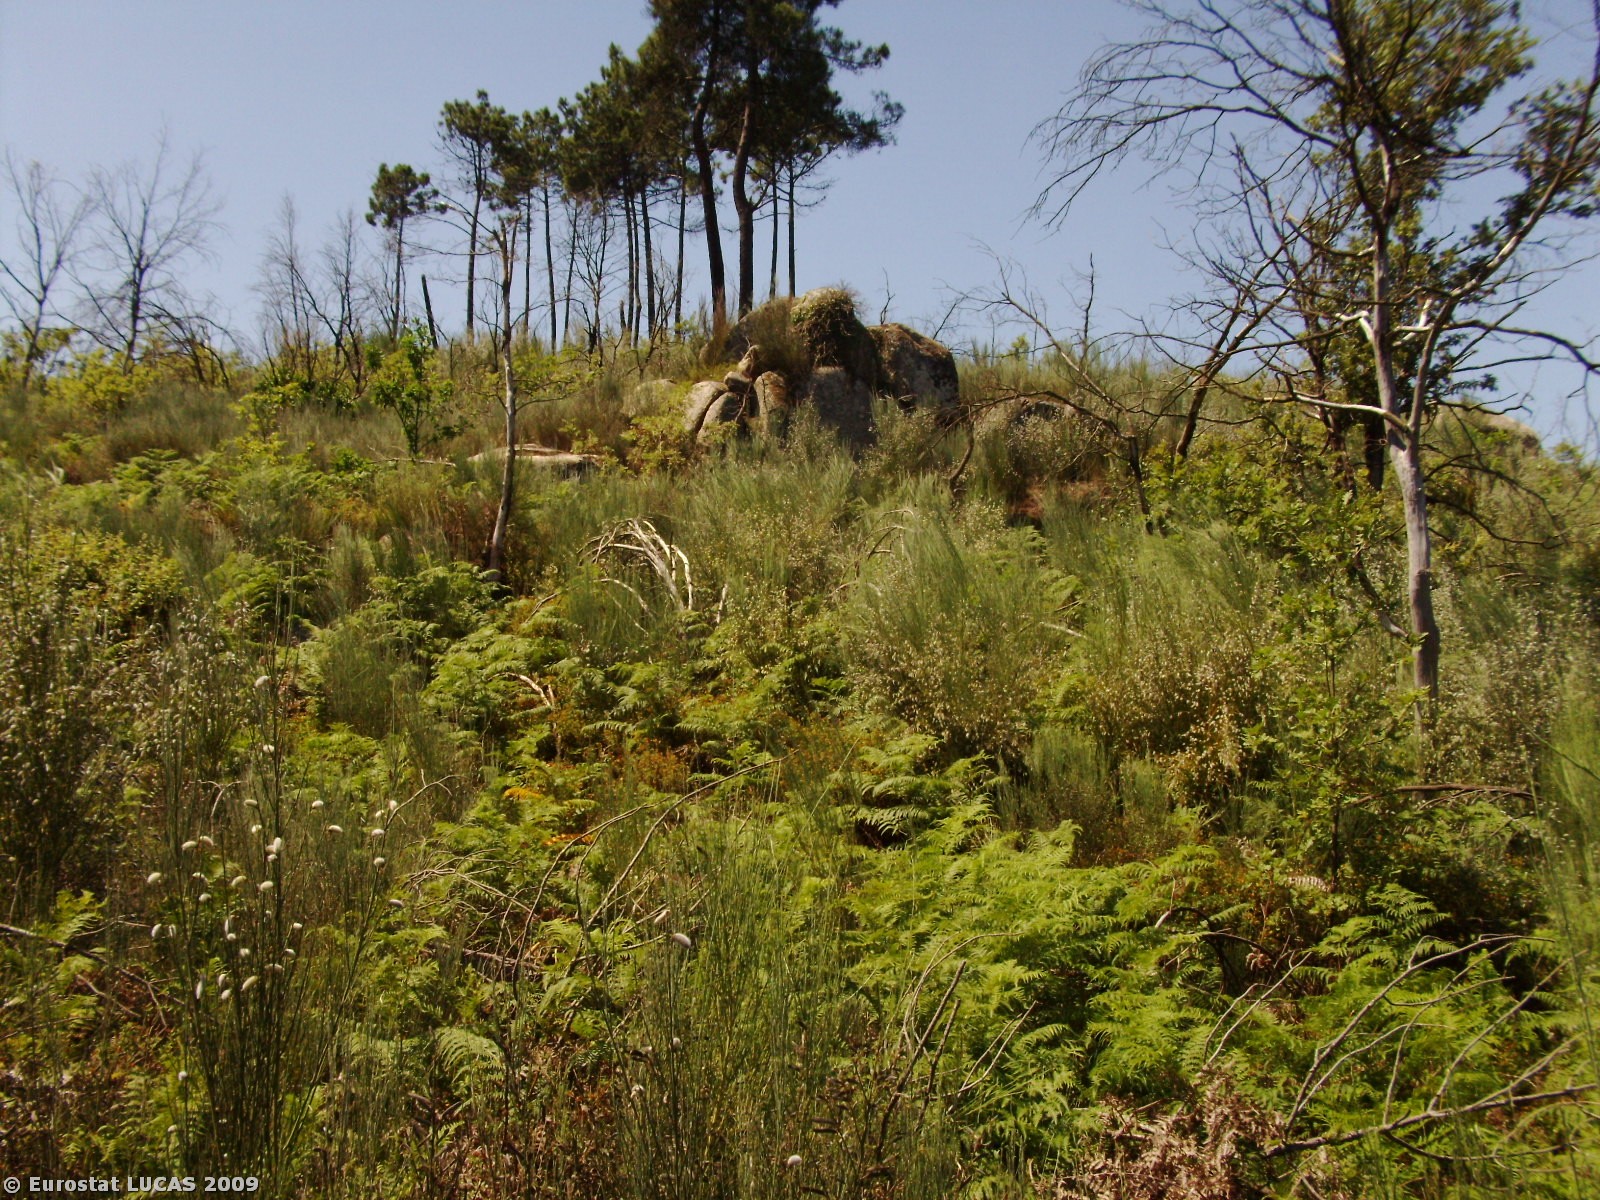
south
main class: Woodland
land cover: Broadleaved woodland
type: mesophytic deciduous forest
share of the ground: 10 - 25 %
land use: Forestry
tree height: > 5 m
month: July
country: PT
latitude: 40.6634
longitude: -7.6595
